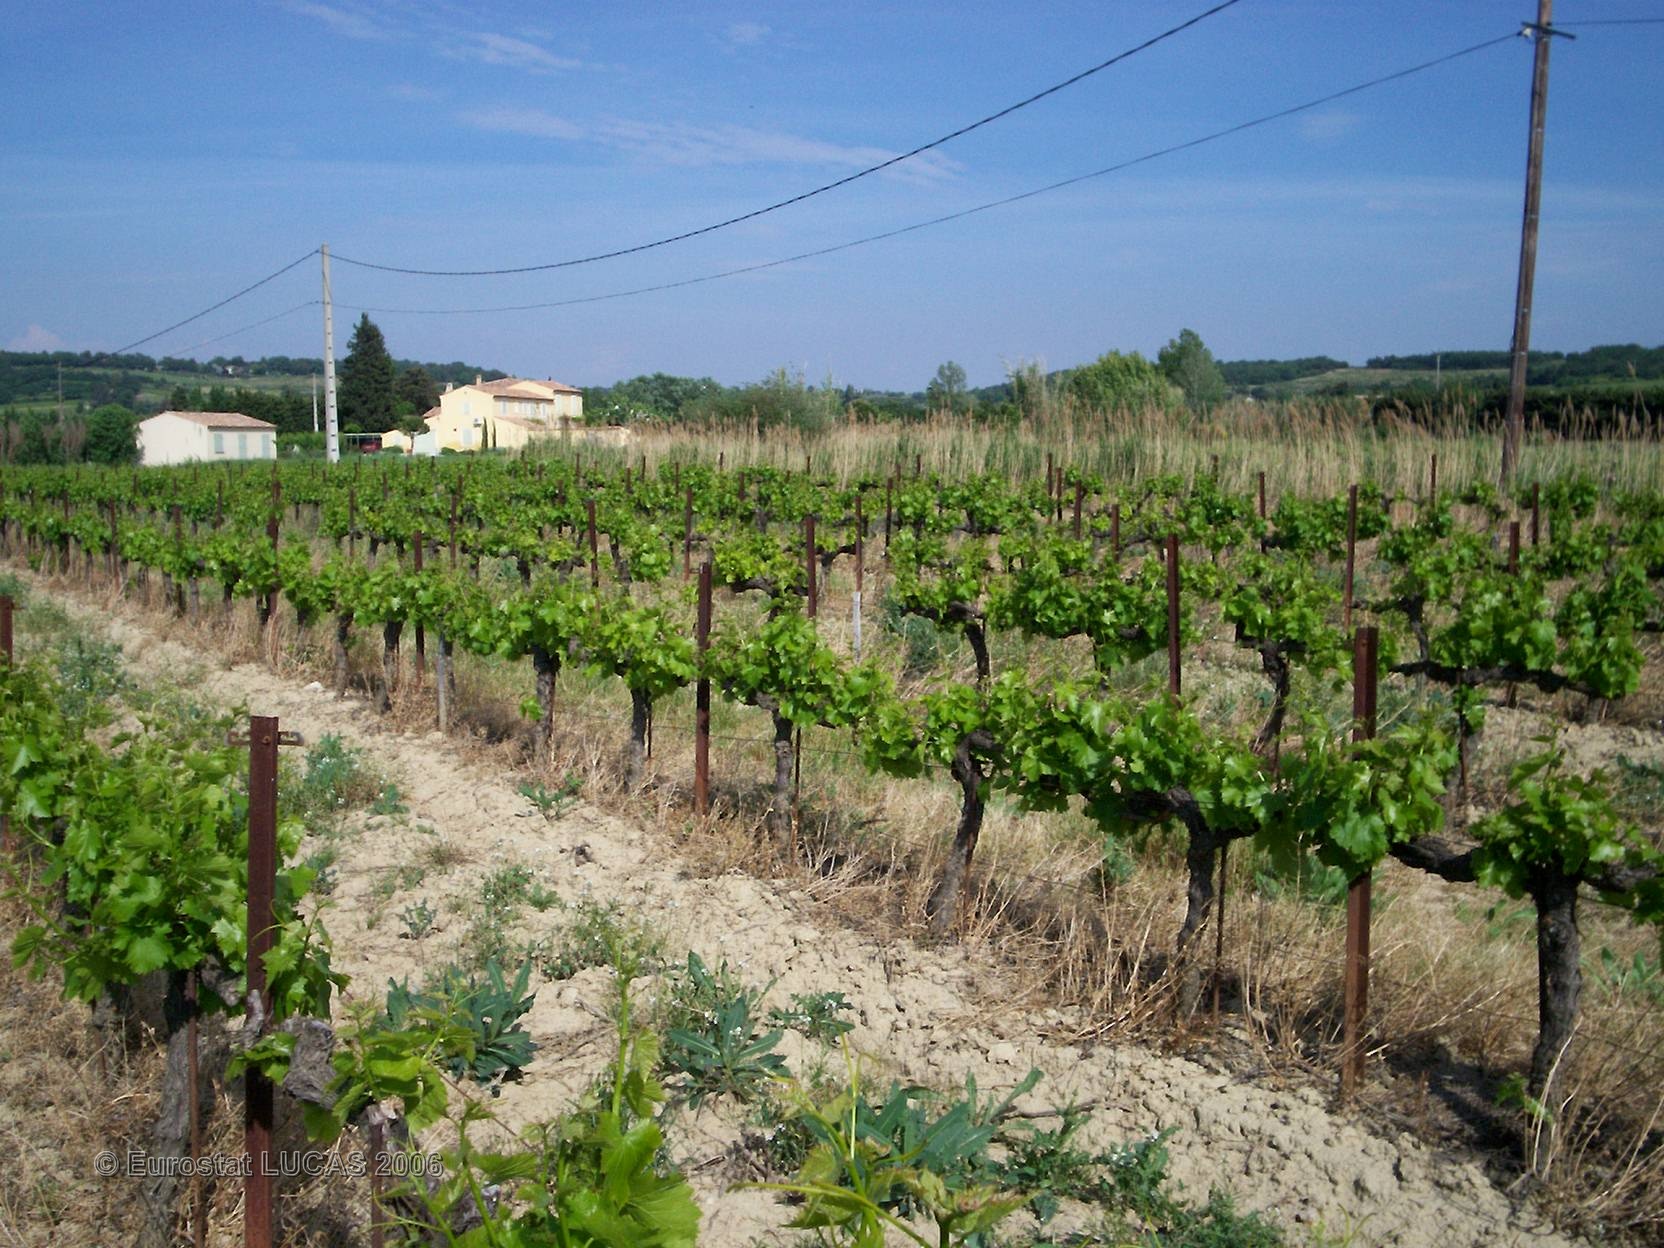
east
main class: Cropland
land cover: Vineyards
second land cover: Grassland with sparse tree/shrub cover
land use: Agriculture (excluding fallow land and kitchen gardens)
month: May
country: FR
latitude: 44.2990
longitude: 4.9313
